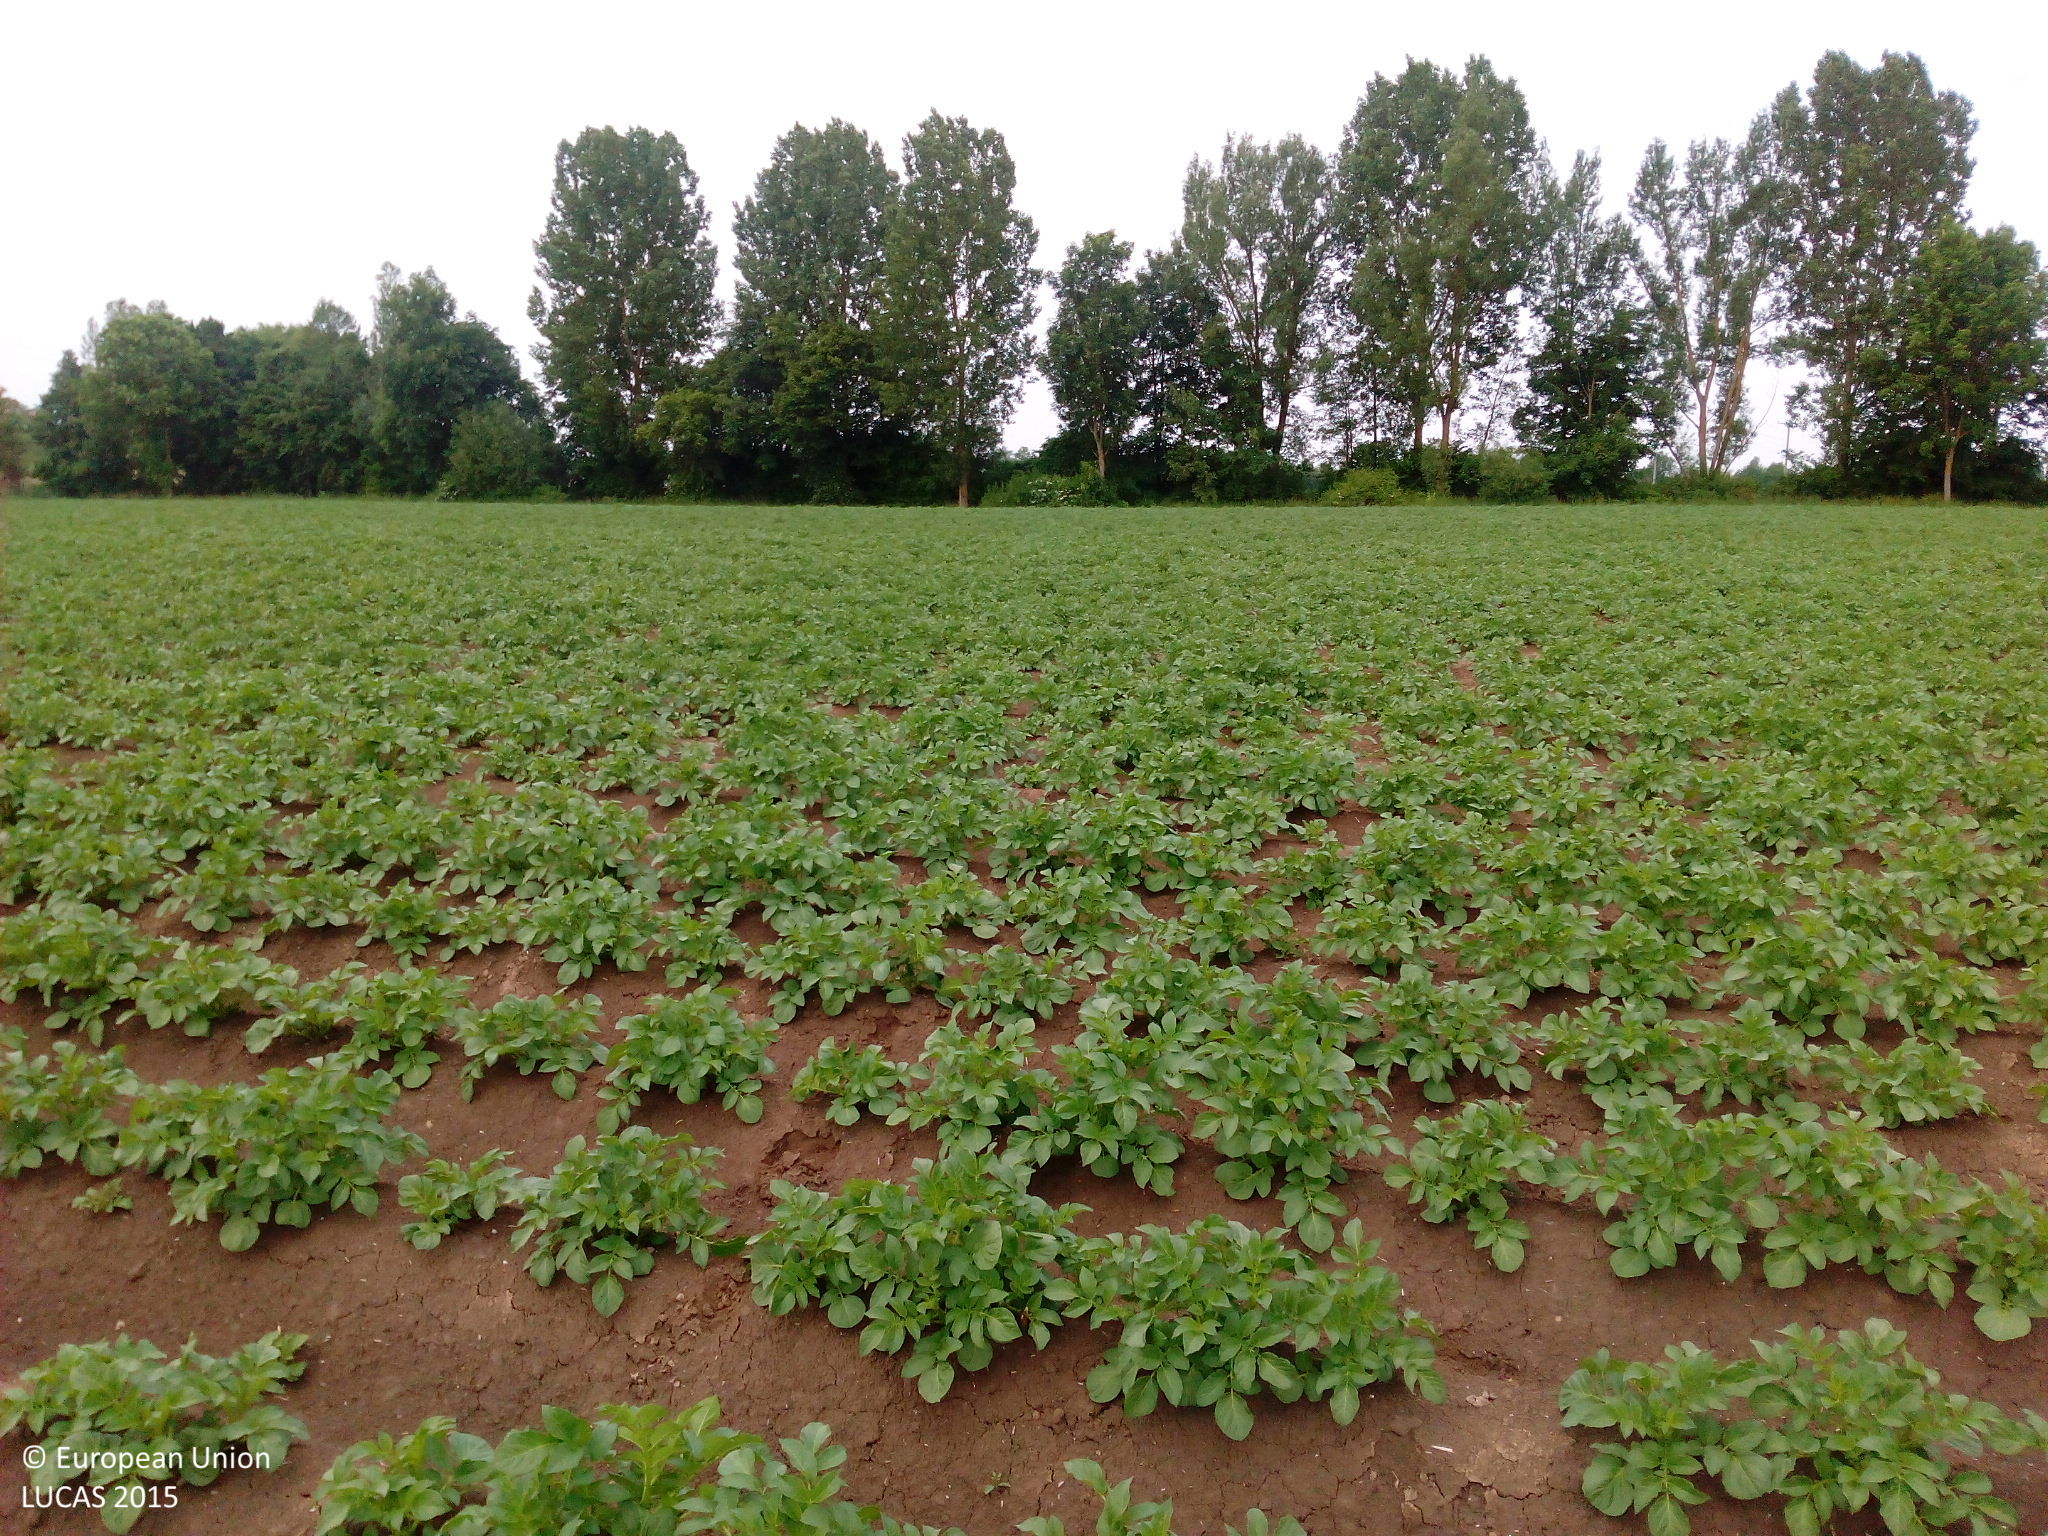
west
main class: Cropland
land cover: Potatoes
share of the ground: > 75 %
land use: Agriculture (excluding fallow land and kitchen gardens)
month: May
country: DE
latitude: 48.9728
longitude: 12.3355
